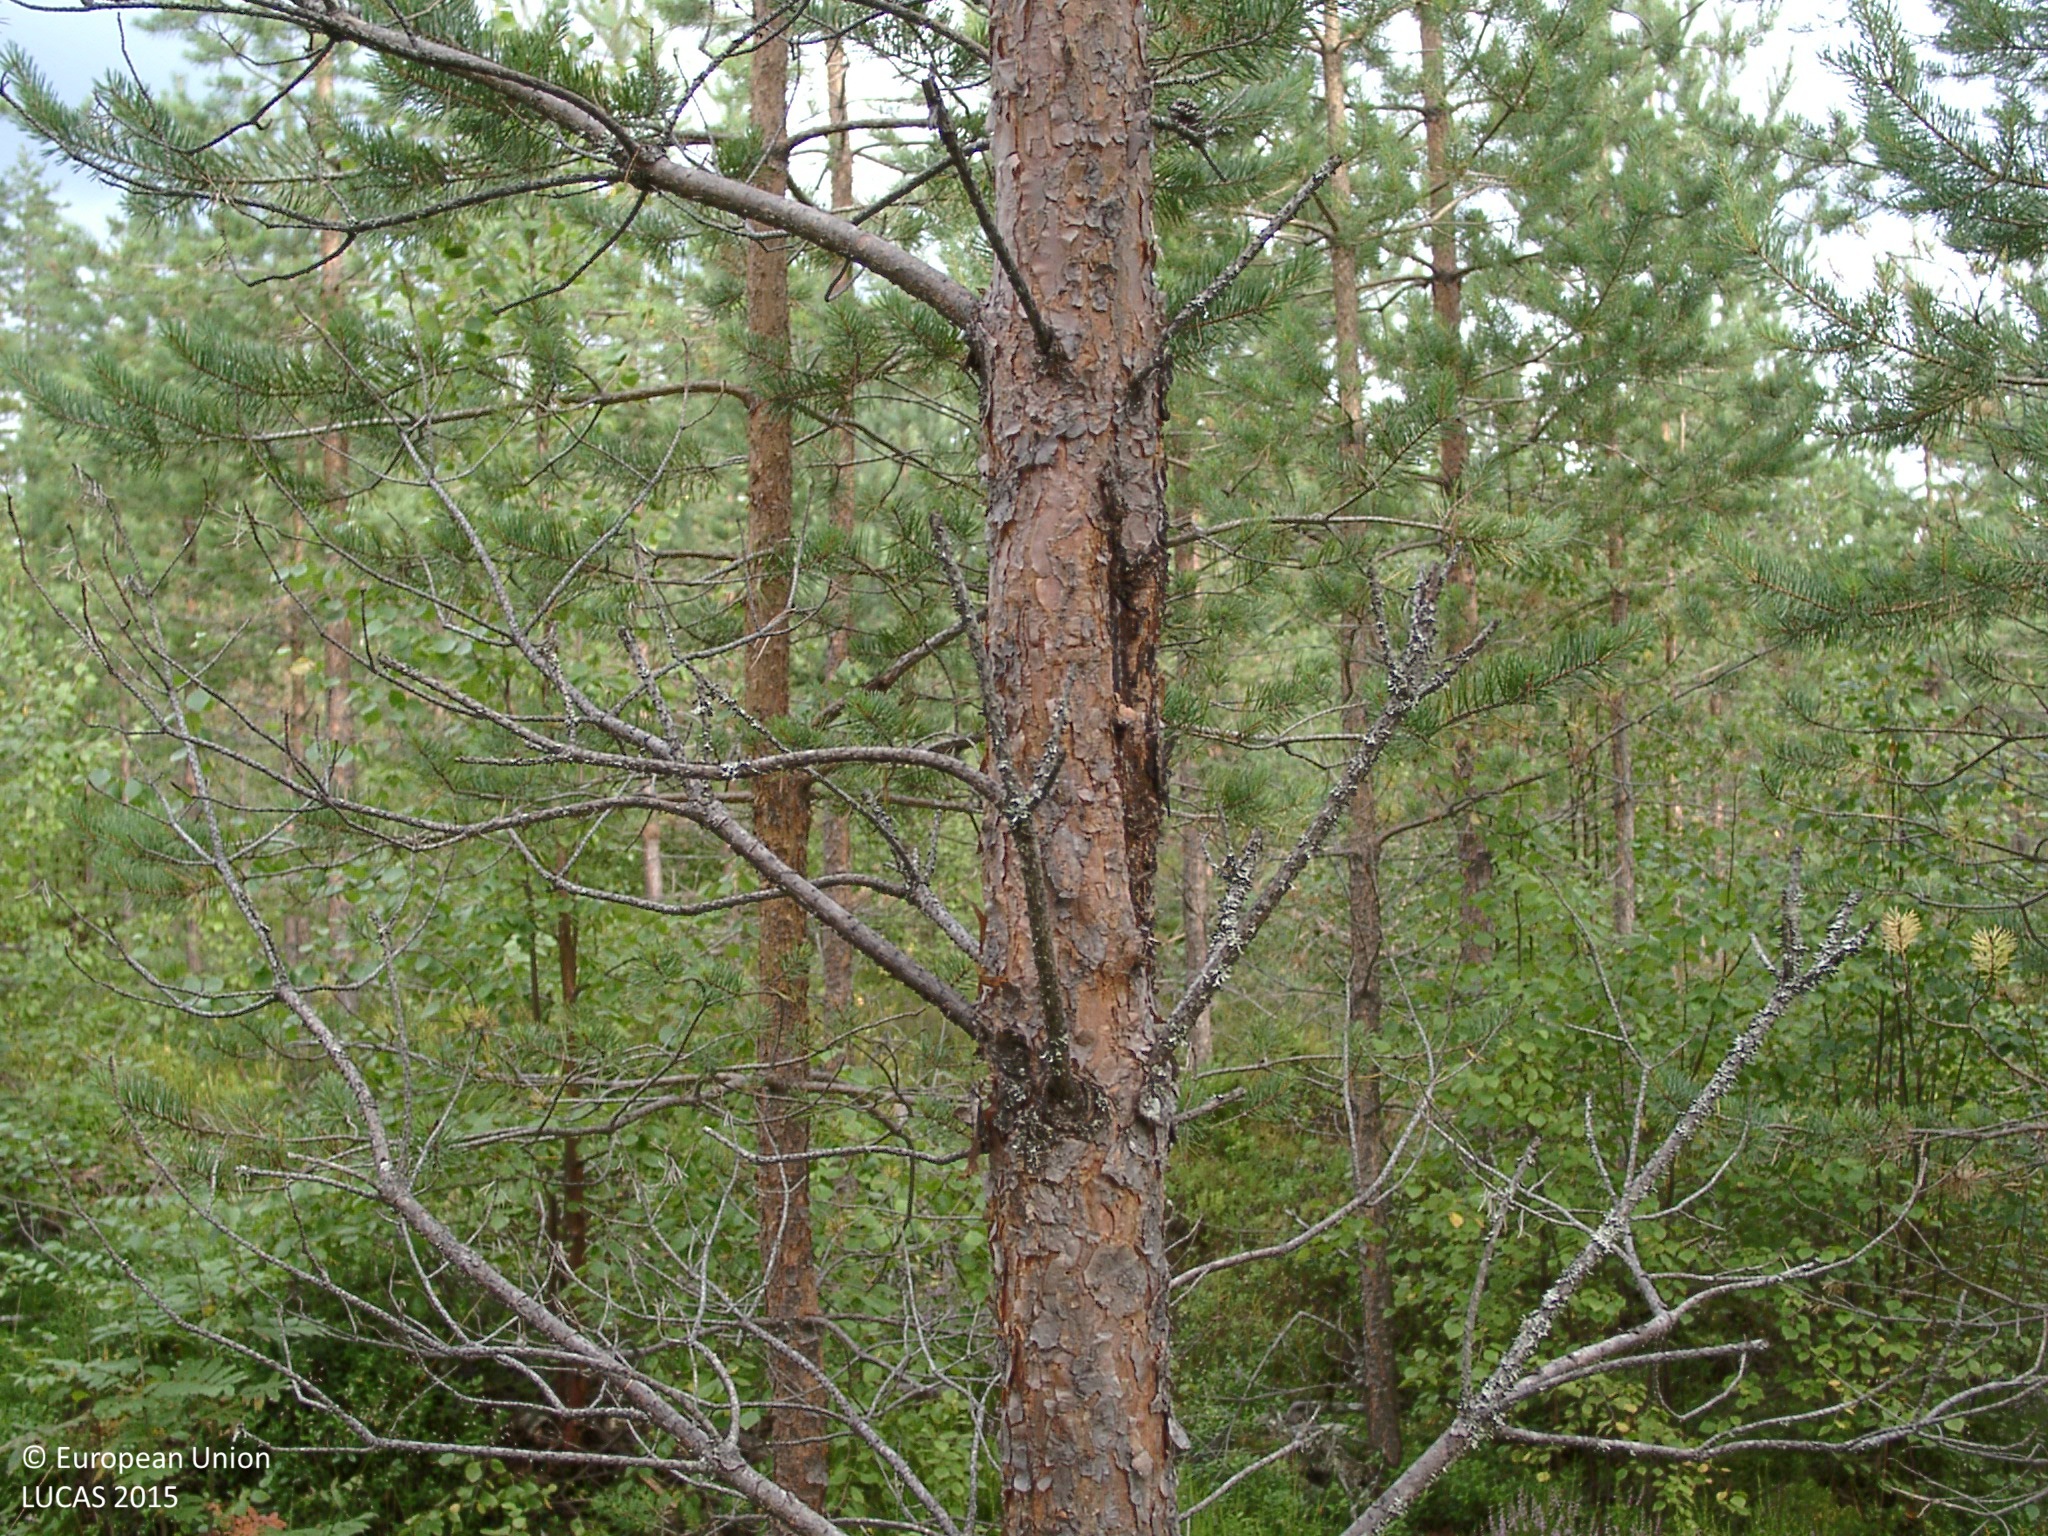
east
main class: Woodland
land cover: Pine dominated coniferous woodland
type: boreal forest
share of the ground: 50 - 75 %
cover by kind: coniferous forest trees 55 %, shrubs 25 %, broadleaved forest trees 10 %, lichens and mosses 10 %
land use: Forestry
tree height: < 5 m
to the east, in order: Pine dominated coniferous woodland; Ditches and canals; Pine dominated coniferous woodland; Ditches and canals; Pine dominated coniferous woodland; Ditches and canals; Pine dominated coniferous woodland; Ditches and canals; Groves; Shruby margins; Other mixed woodland; Pine dominated coniferous woodland
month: August
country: FI
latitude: 62.5668
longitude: 24.5061
